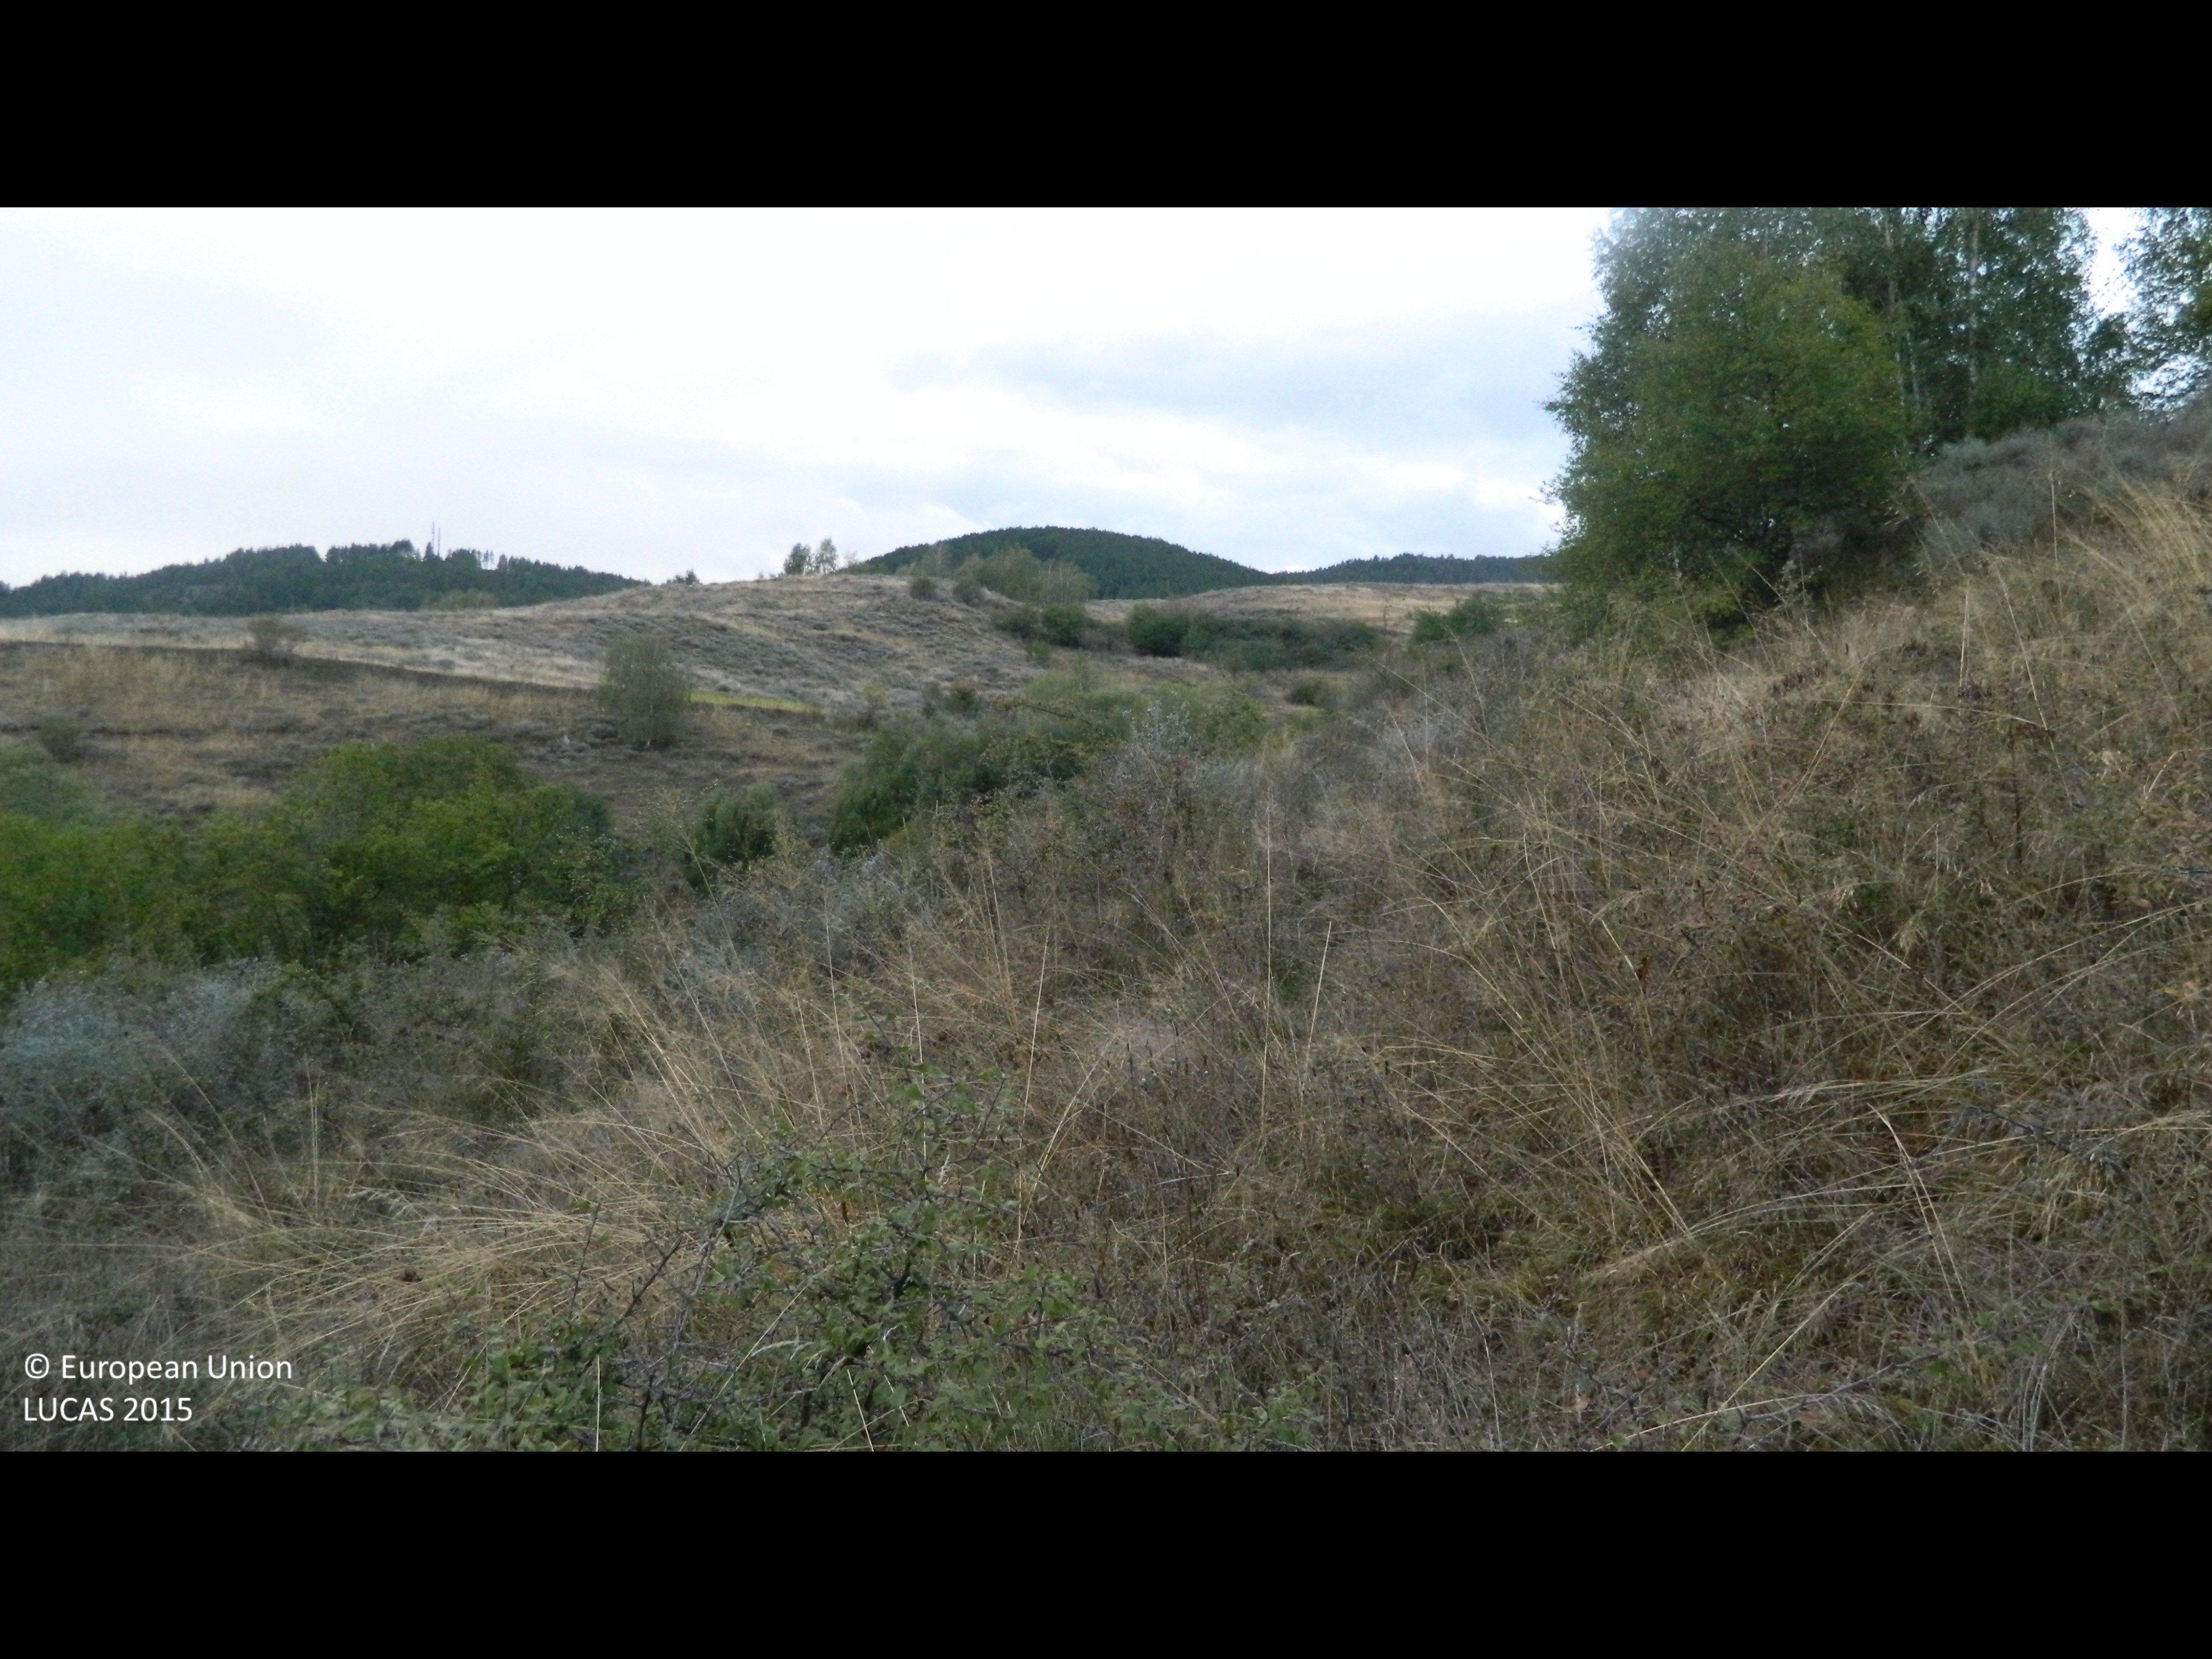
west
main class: Shrubland
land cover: Shrubland with sparse tree cover
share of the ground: > 75 %
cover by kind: shrubs 75 %, herbaceous plants 20 %, broadleaved forest trees 5 %
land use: Abandoned areas
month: September
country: BG
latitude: 41.5948
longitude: 24.0579
